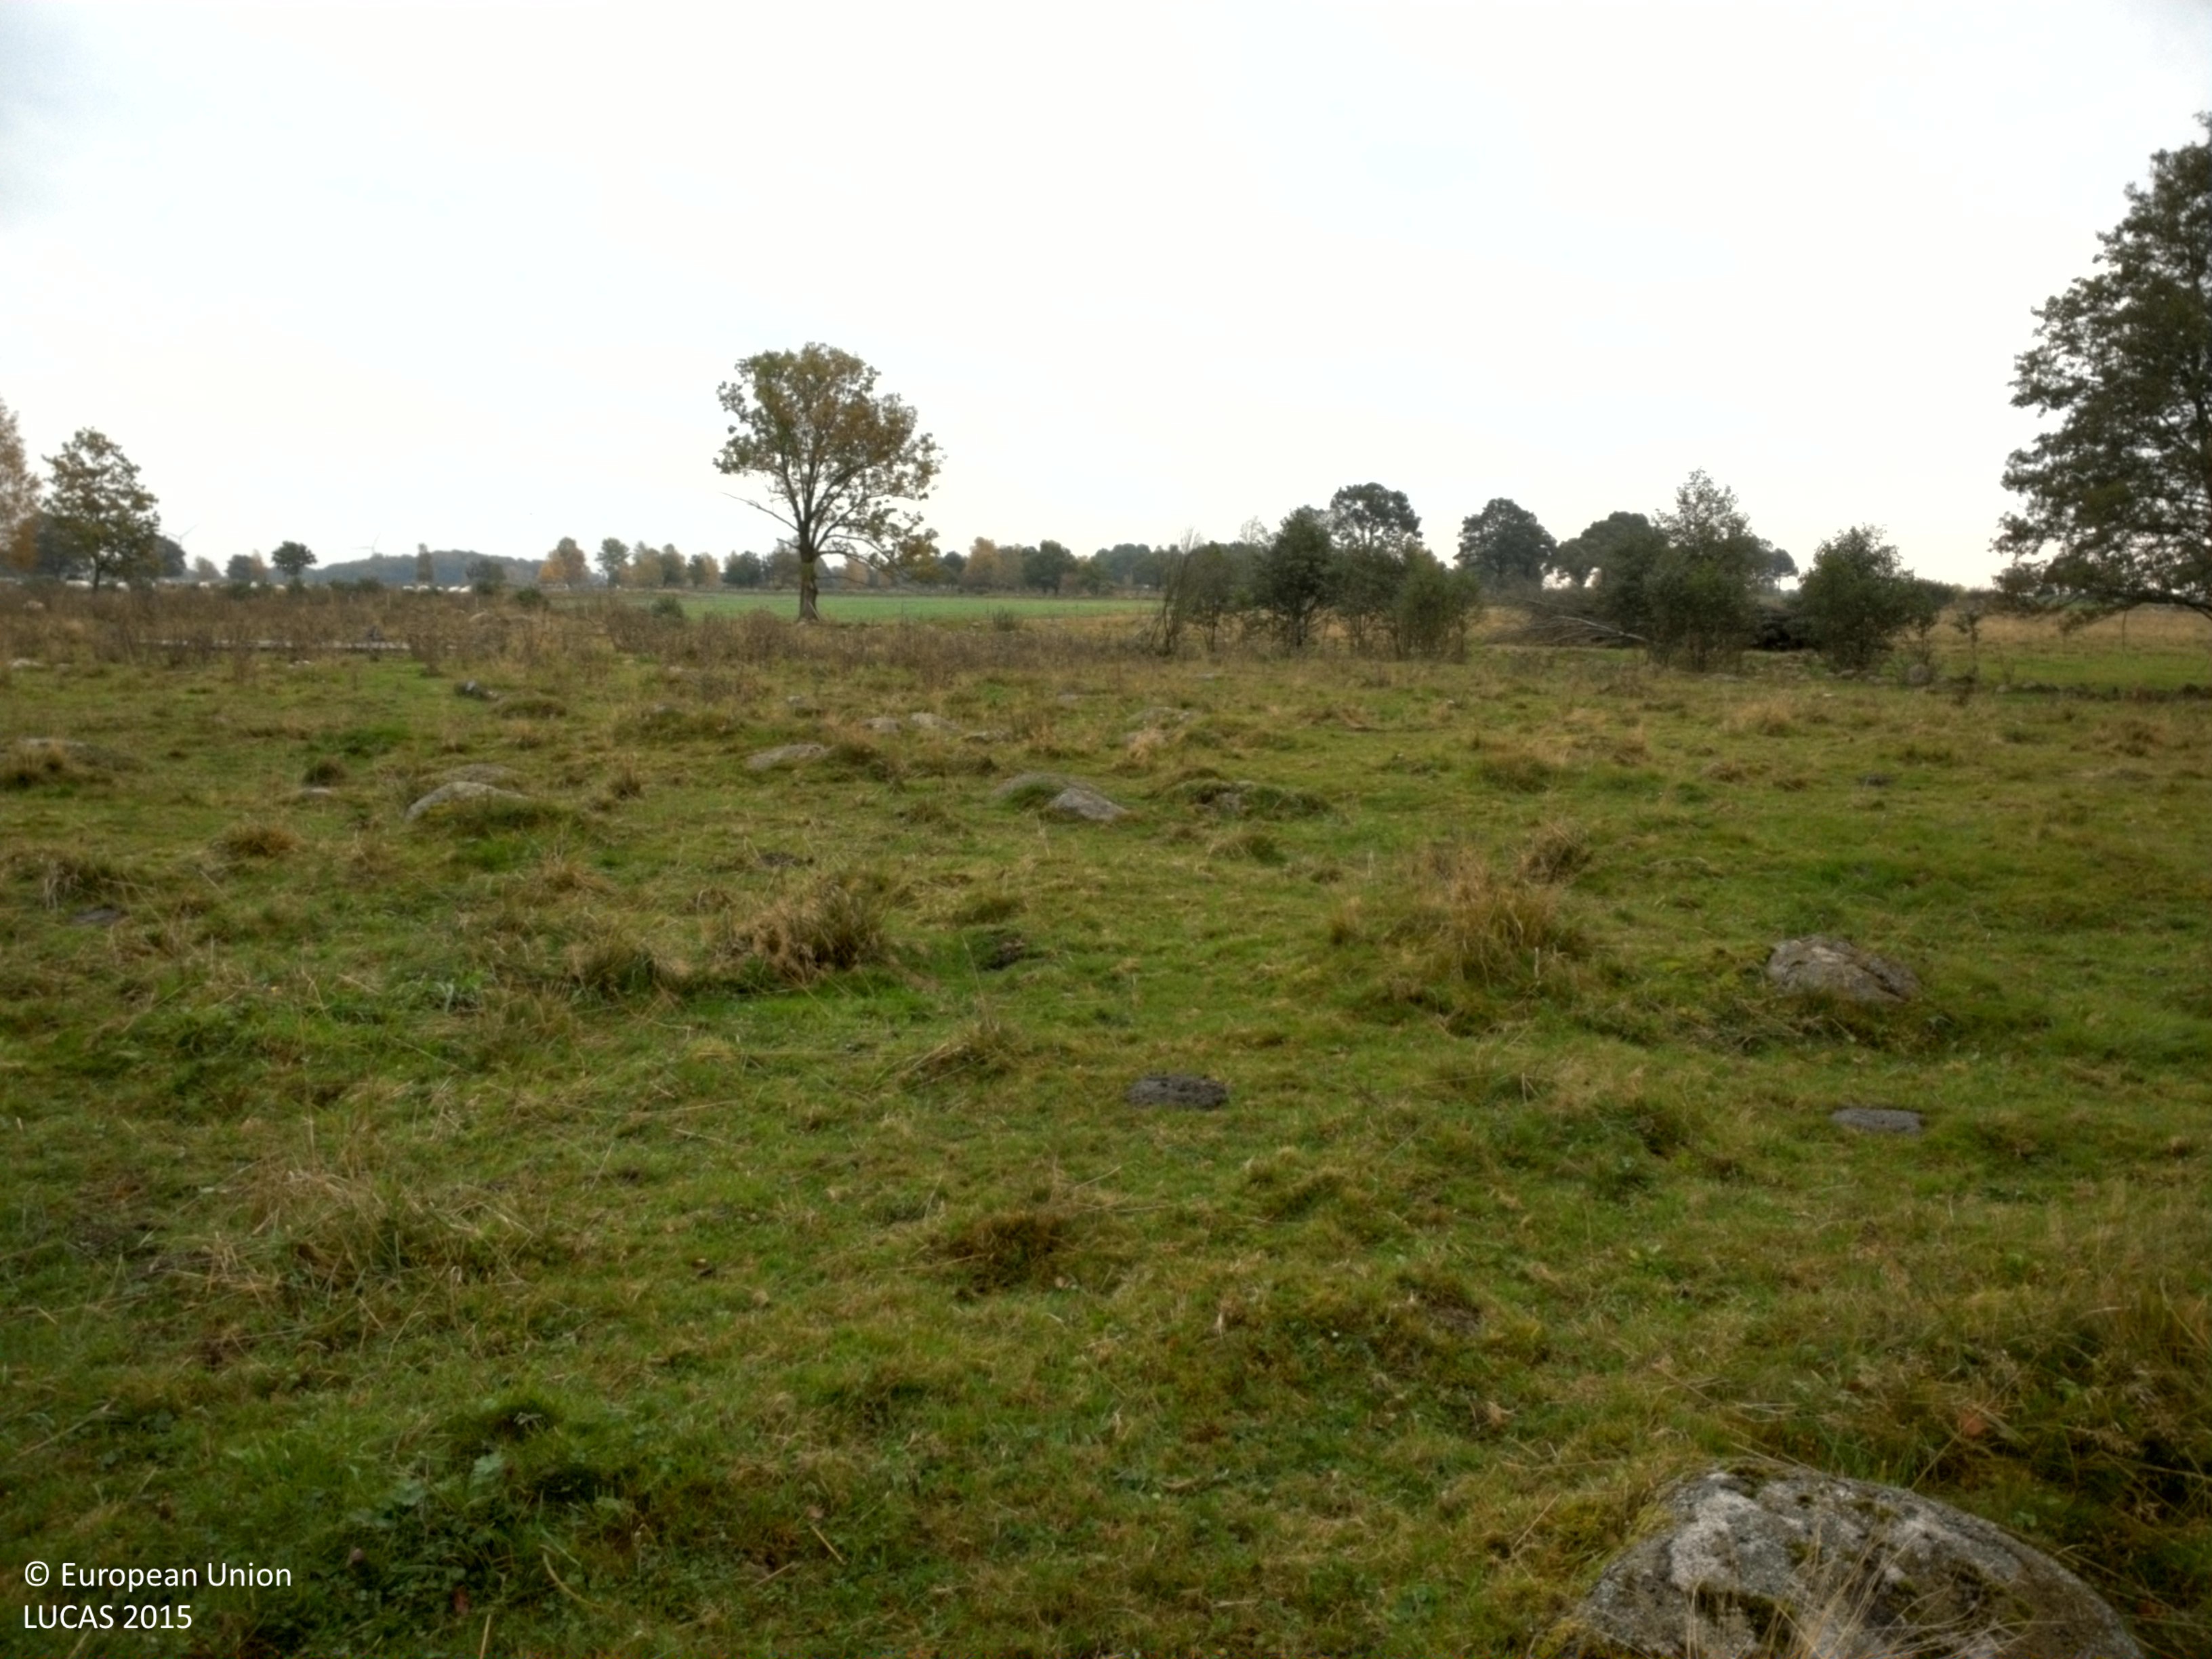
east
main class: Grassland
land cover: Grassland without tree/shrub cover
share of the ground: > 75 %
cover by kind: herbaceous plants 100 %
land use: Agriculture (excluding fallow land and kitchen gardens)
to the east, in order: Grassland without tree/shrub cover; Ditches and canals; Grassland without tree/shrub cover; Fences; Ditches and canals; Paved roads, cycling and walking lanes; Ditches and canals; Rape and turnip rape
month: October
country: SE
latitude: 55.8101
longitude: 13.7158
